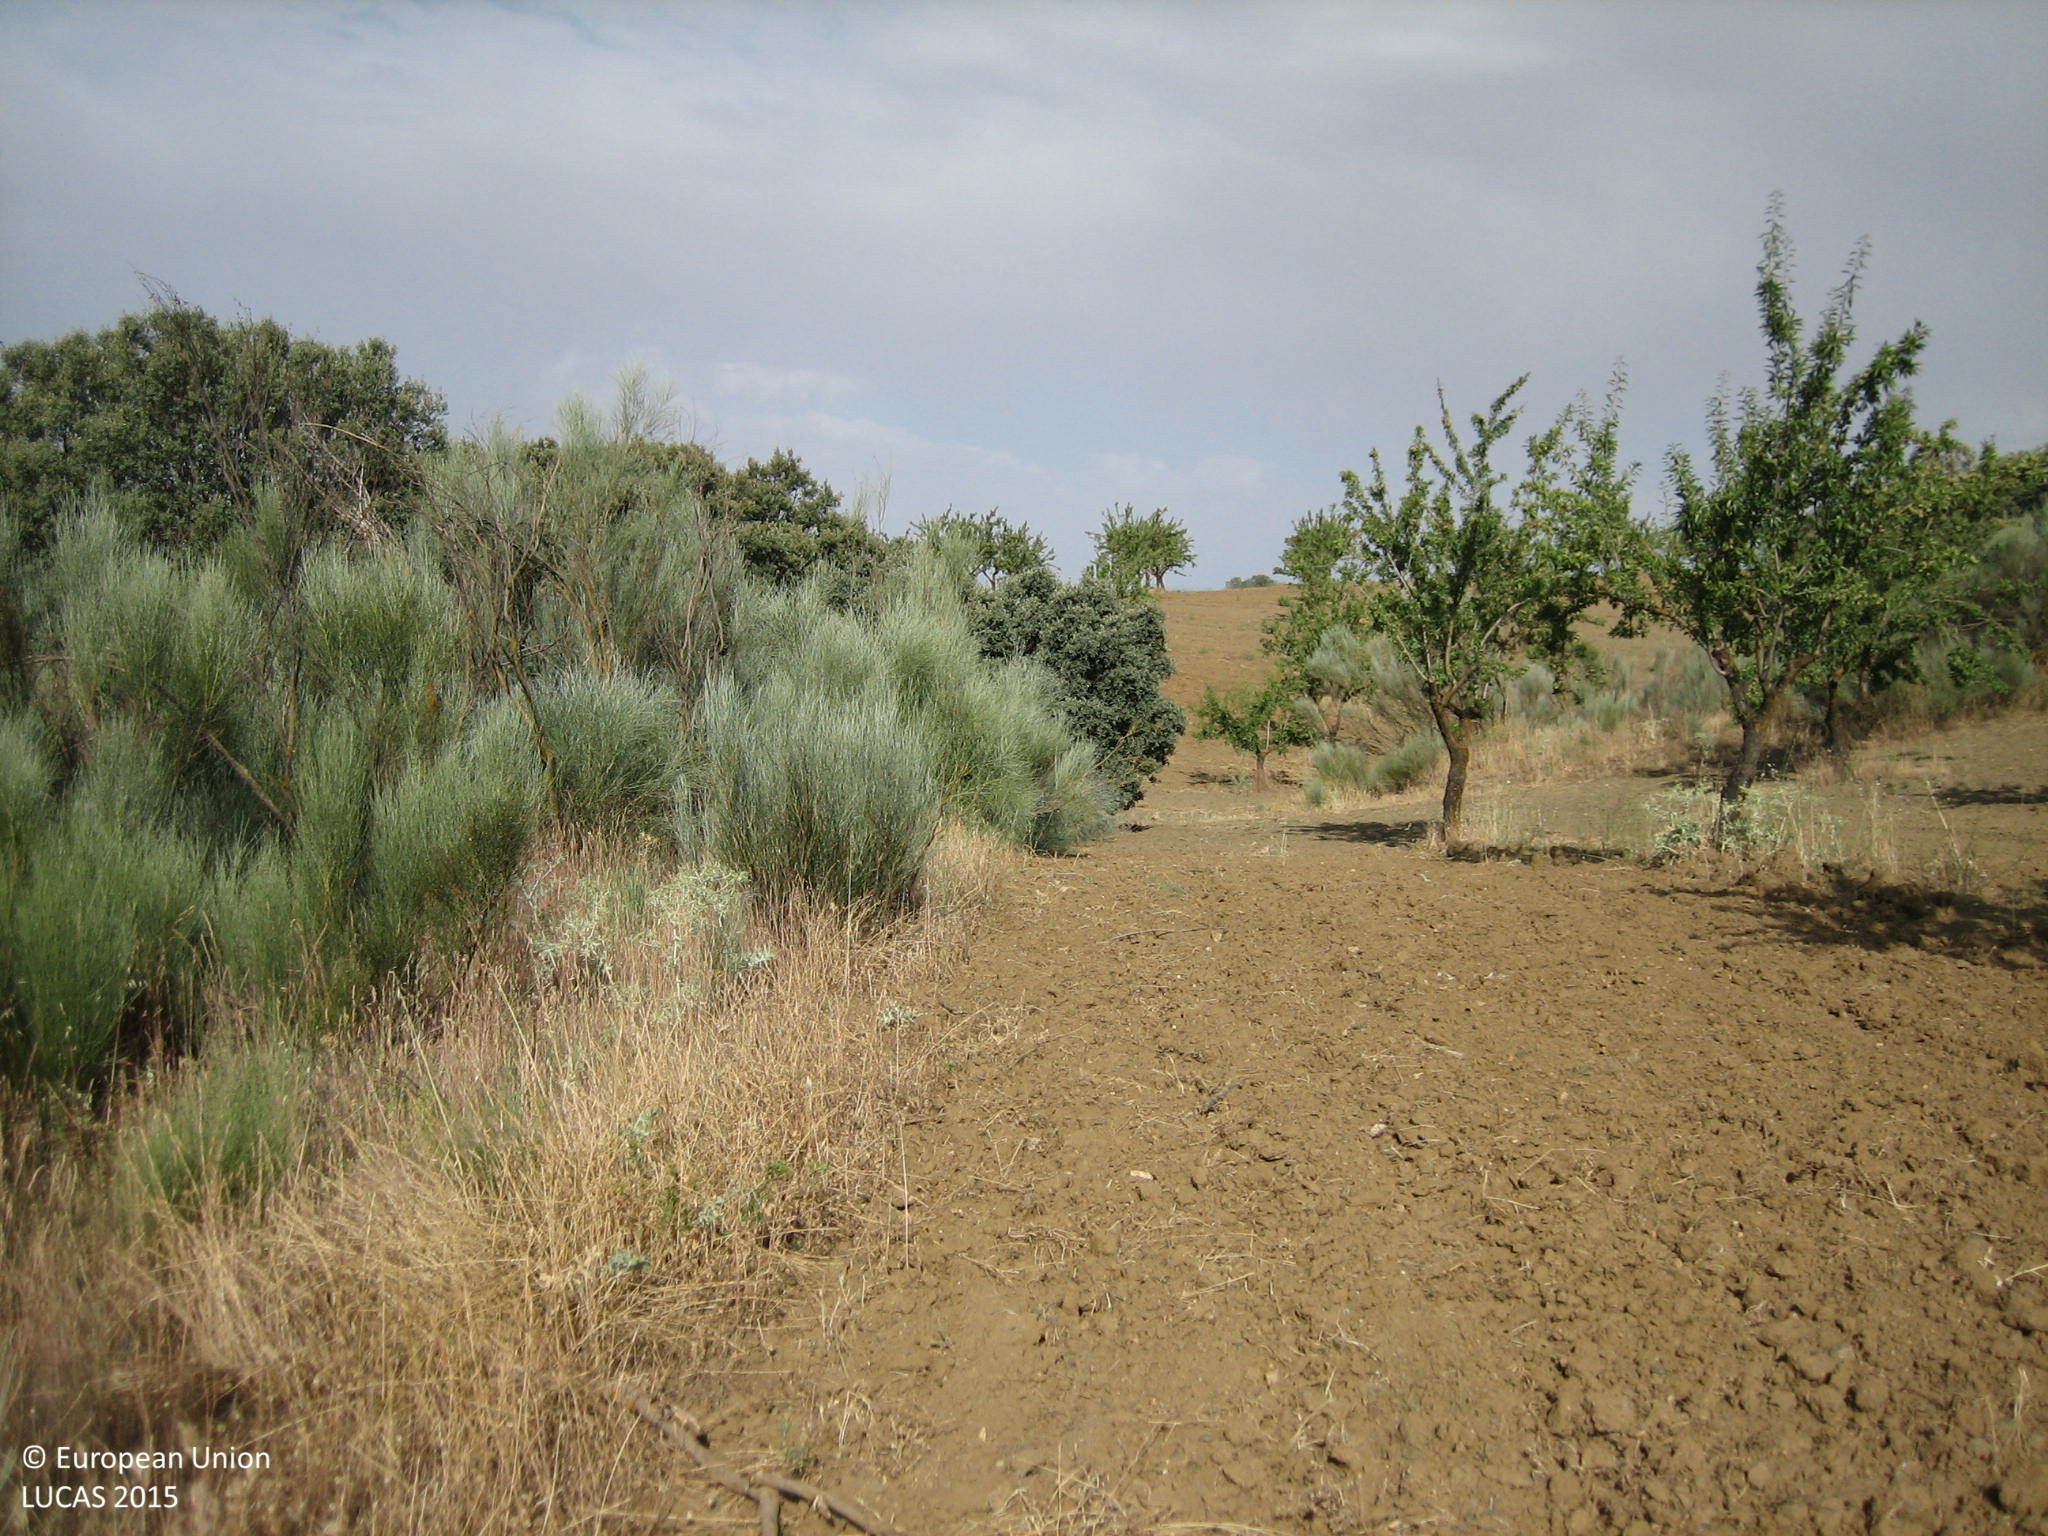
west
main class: Cropland
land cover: Nuts trees
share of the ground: < 10 %
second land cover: Other bare soil
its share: > 75 %
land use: Agriculture (excluding fallow land and kitchen gardens)
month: July
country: ES
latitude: 37.5432
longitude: -2.3554
